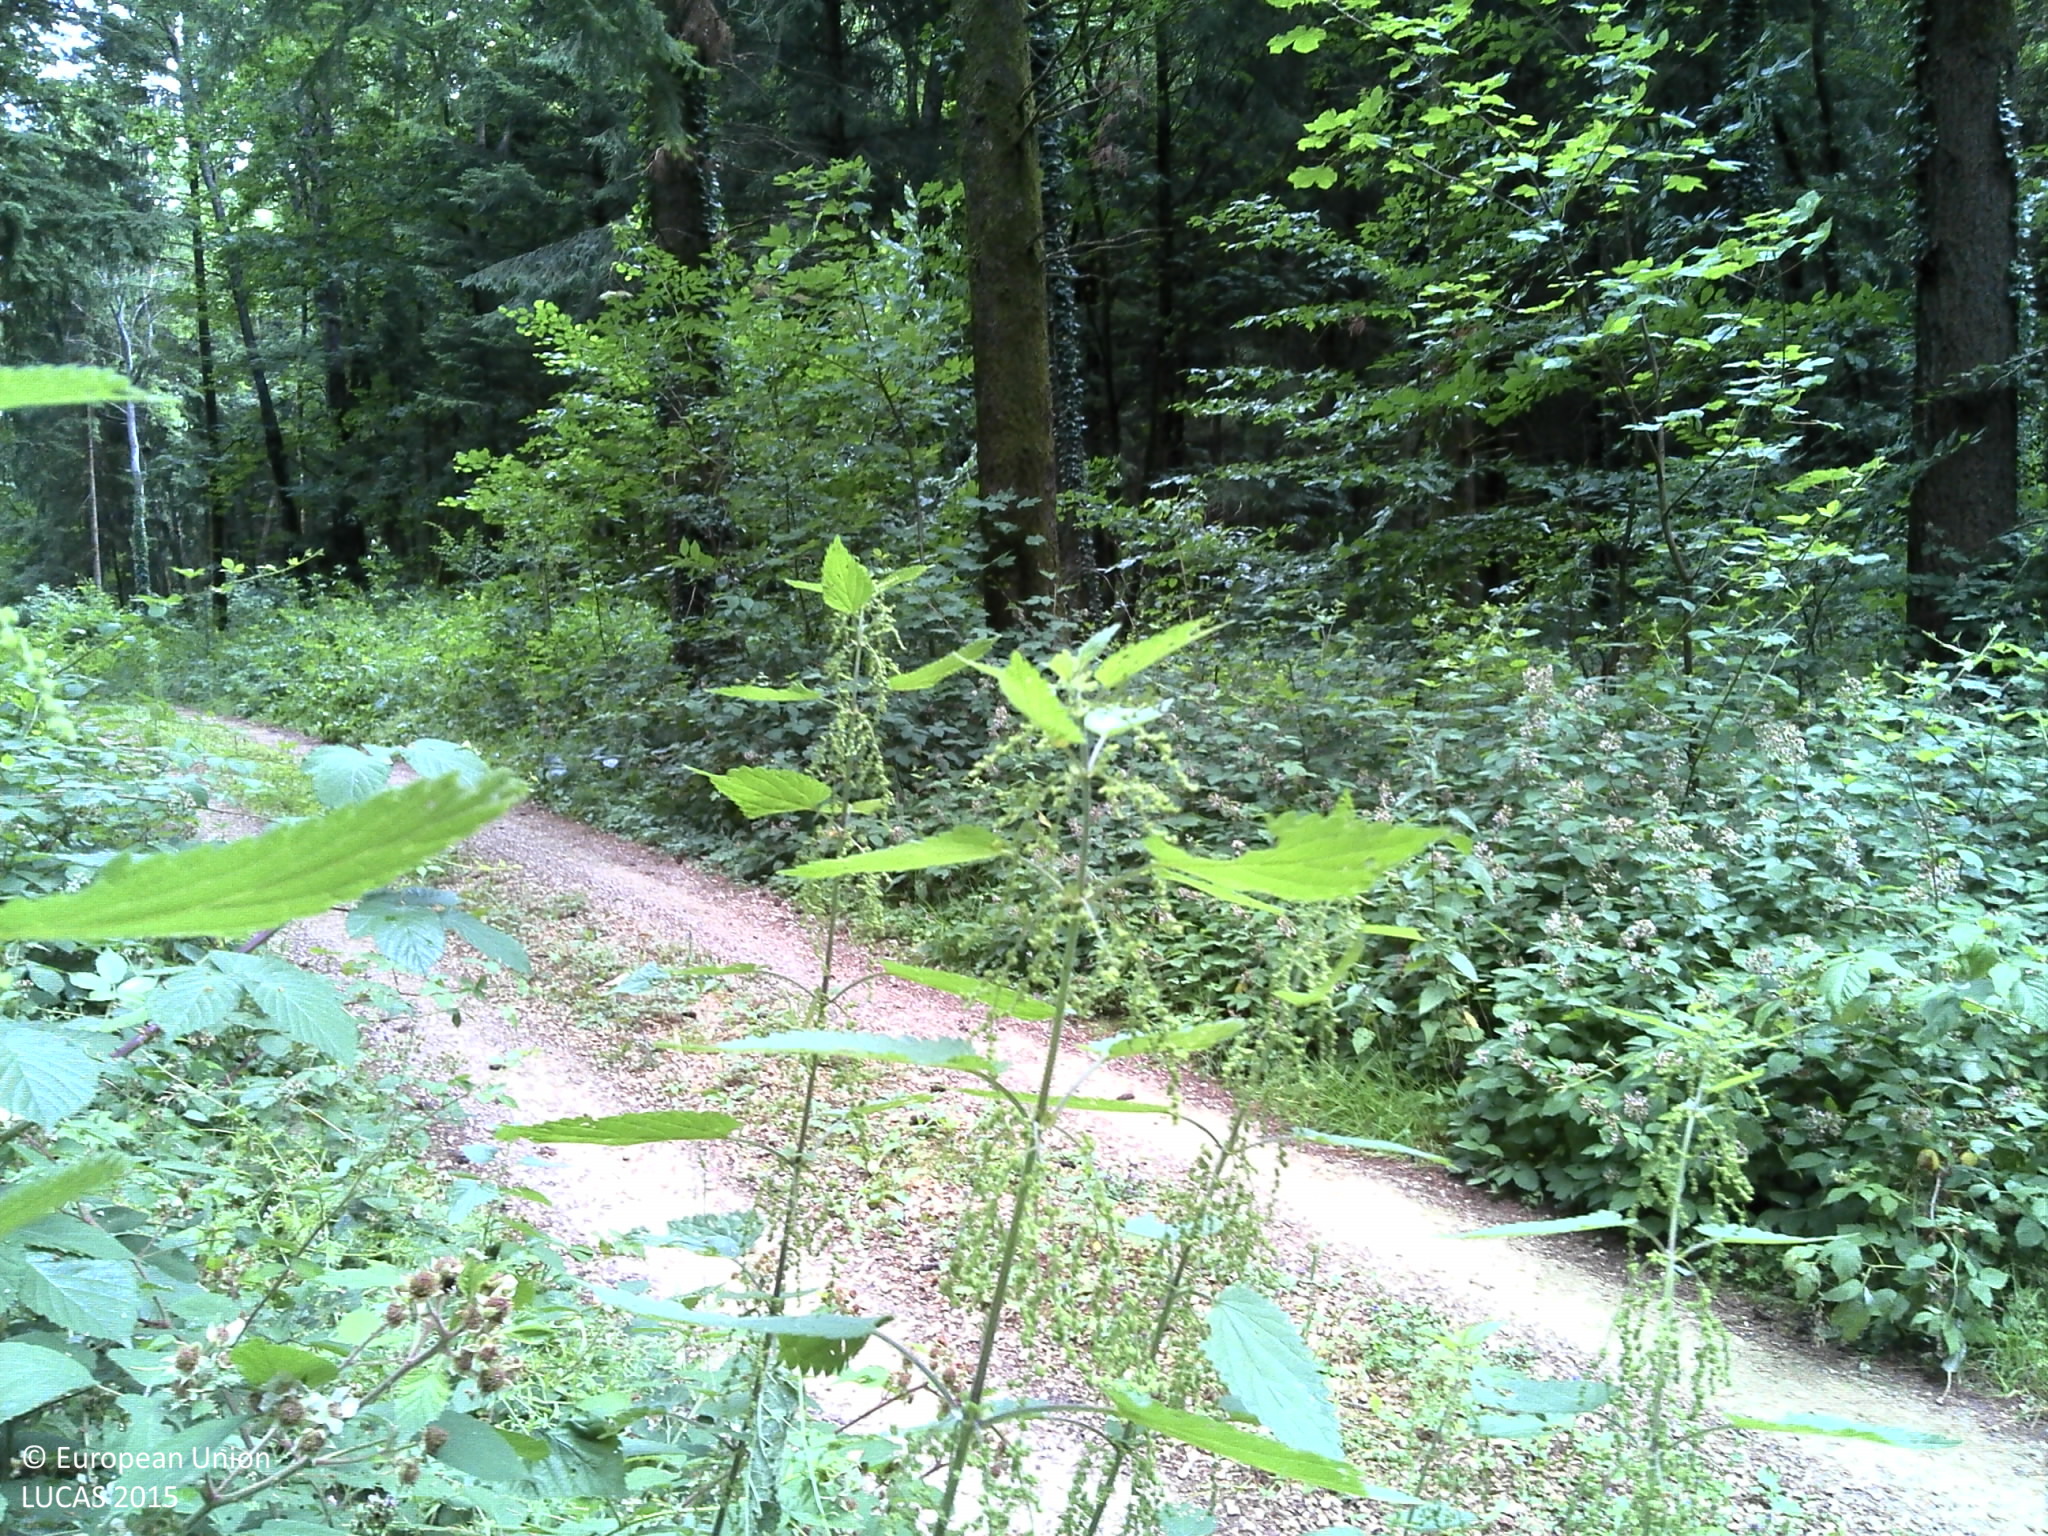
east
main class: Woodland
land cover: Spruce dominated coniferous woodland
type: exotic forest
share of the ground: > 75 %
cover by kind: coniferous forest trees 75 %, herbaceous plants 20 %, broadleaved forest trees 5 %
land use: Forestry
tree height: > 5 m
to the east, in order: Spruce dominated coniferous woodland; Tracks; Spruce dominated coniferous woodland; Tracks; Spruce dominated coniferous woodland
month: July
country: LU
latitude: 49.4493
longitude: 6.0406
